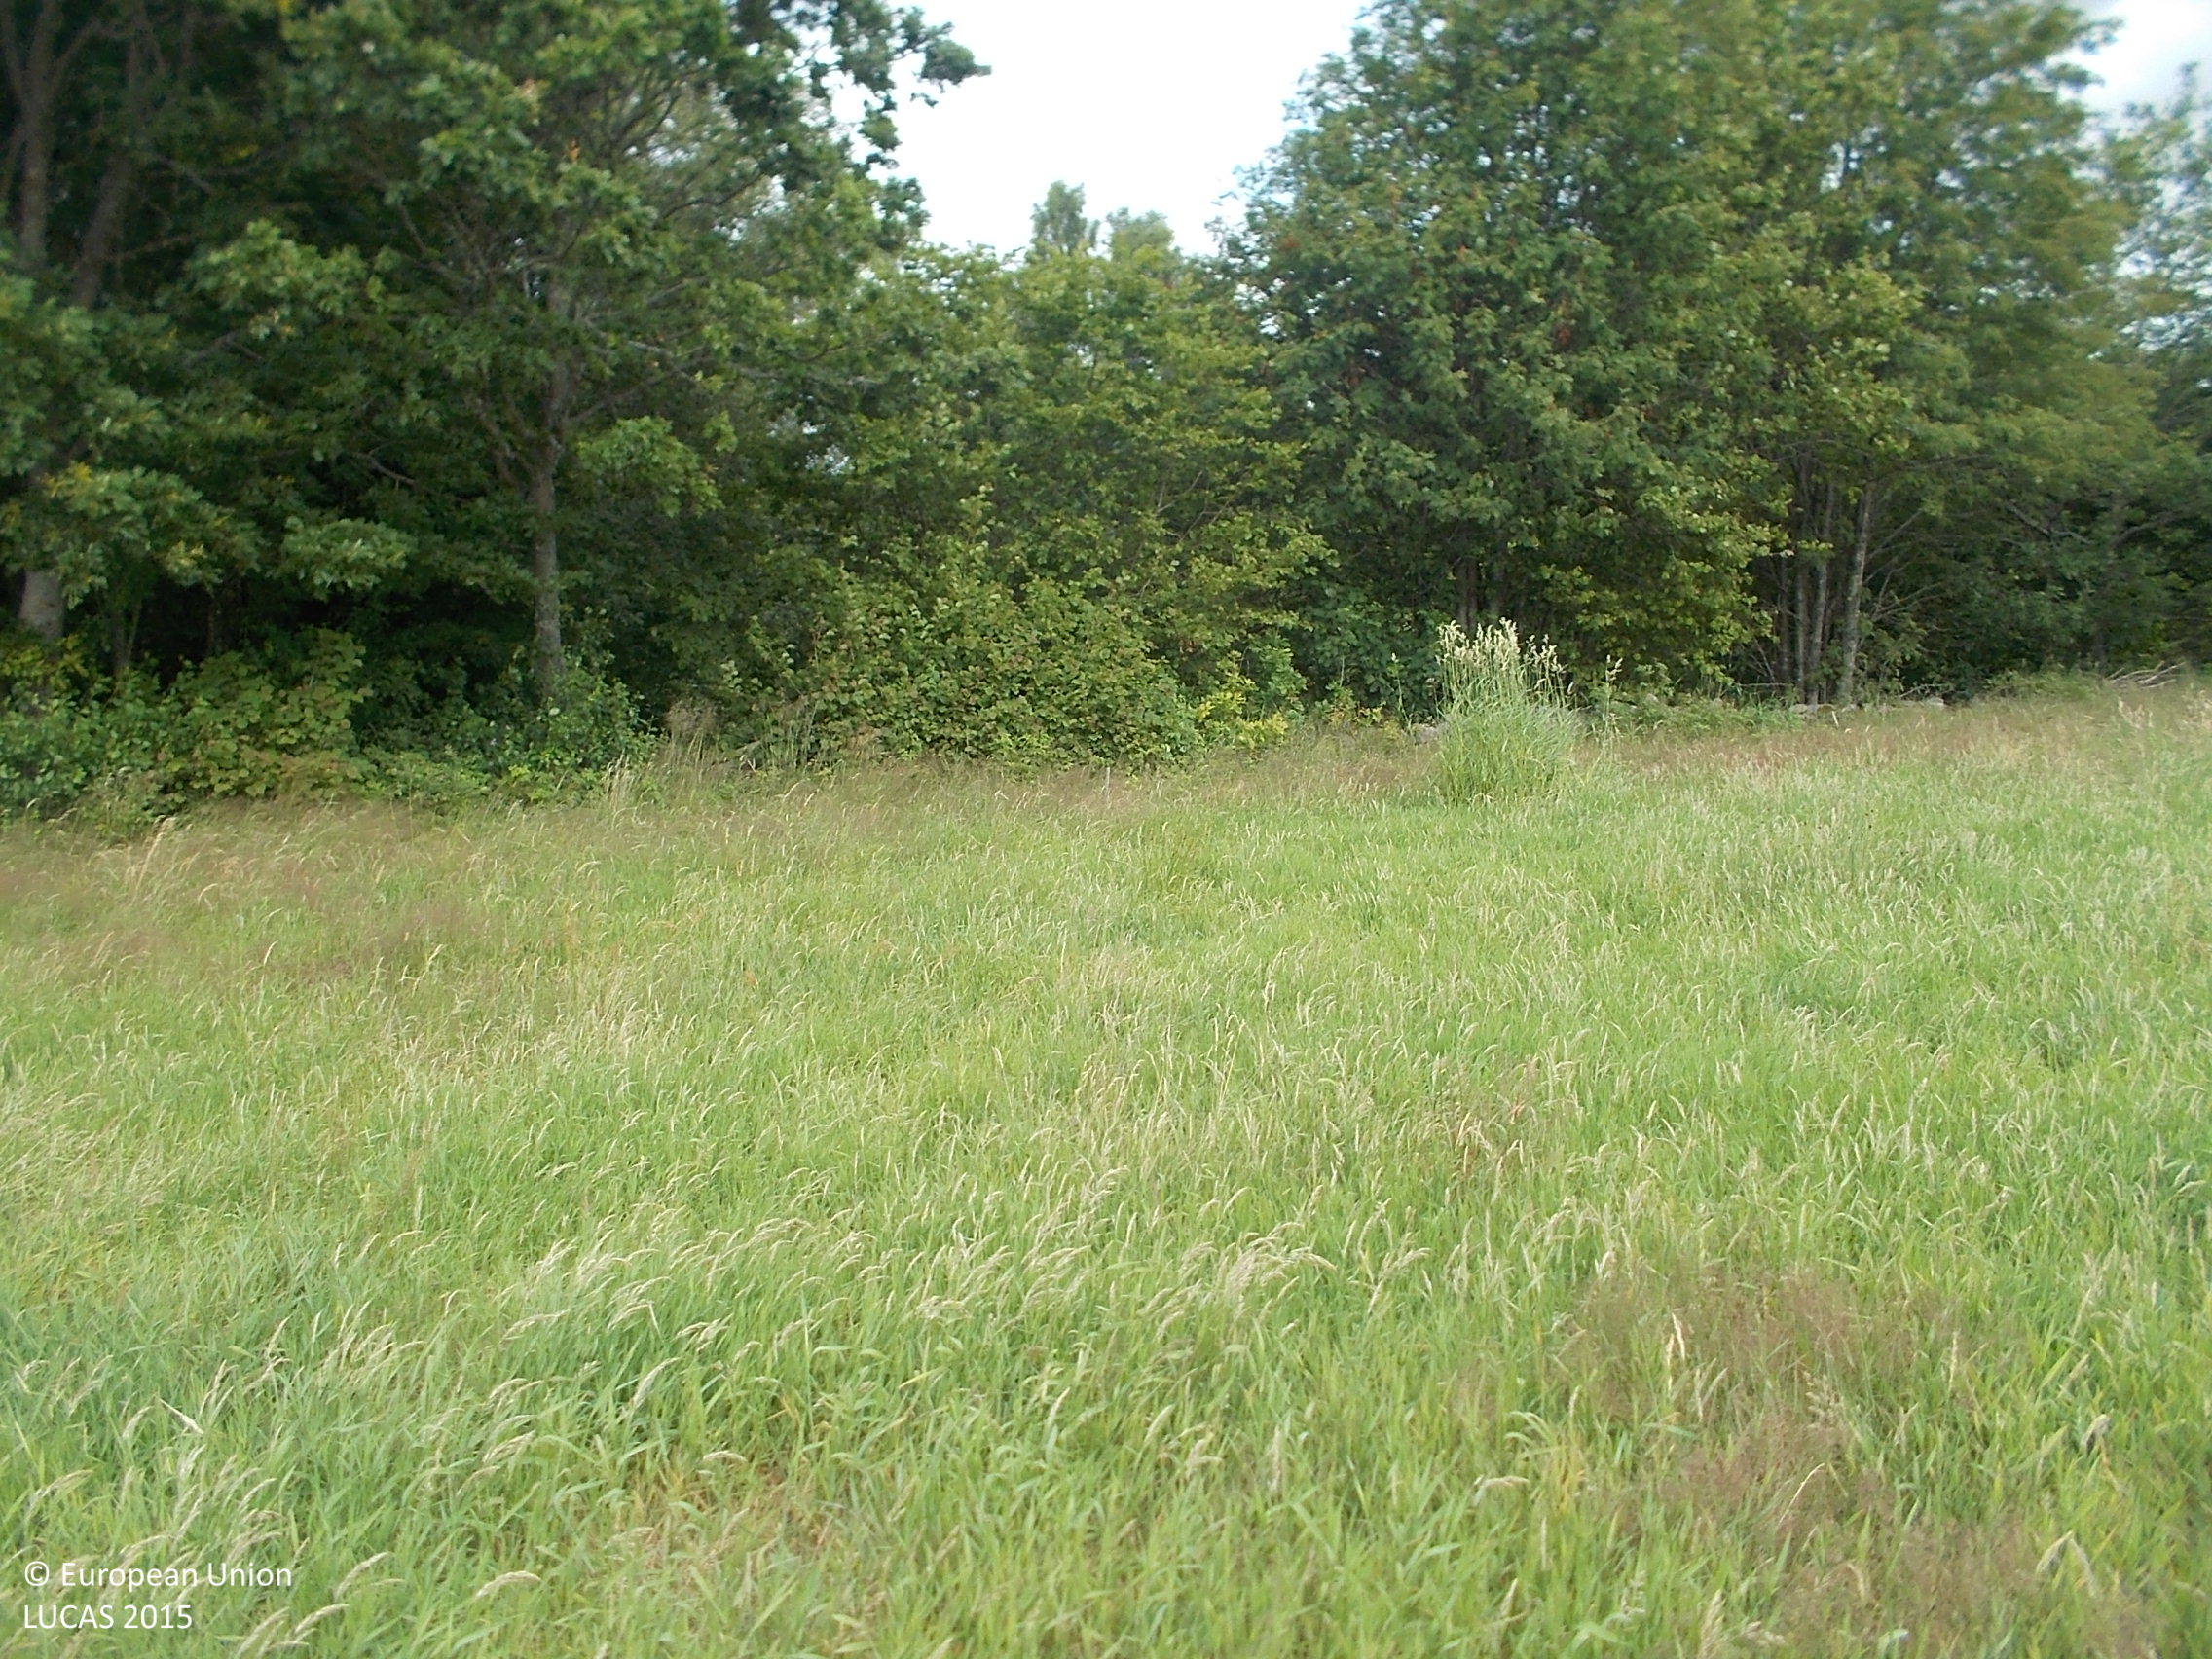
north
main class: Grassland
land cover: Grassland without tree/shrub cover
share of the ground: > 75 %
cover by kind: herbaceous plants 100 %
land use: Agriculture (excluding fallow land and kitchen gardens)
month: July
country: SE
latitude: 57.4266
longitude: 12.2781
